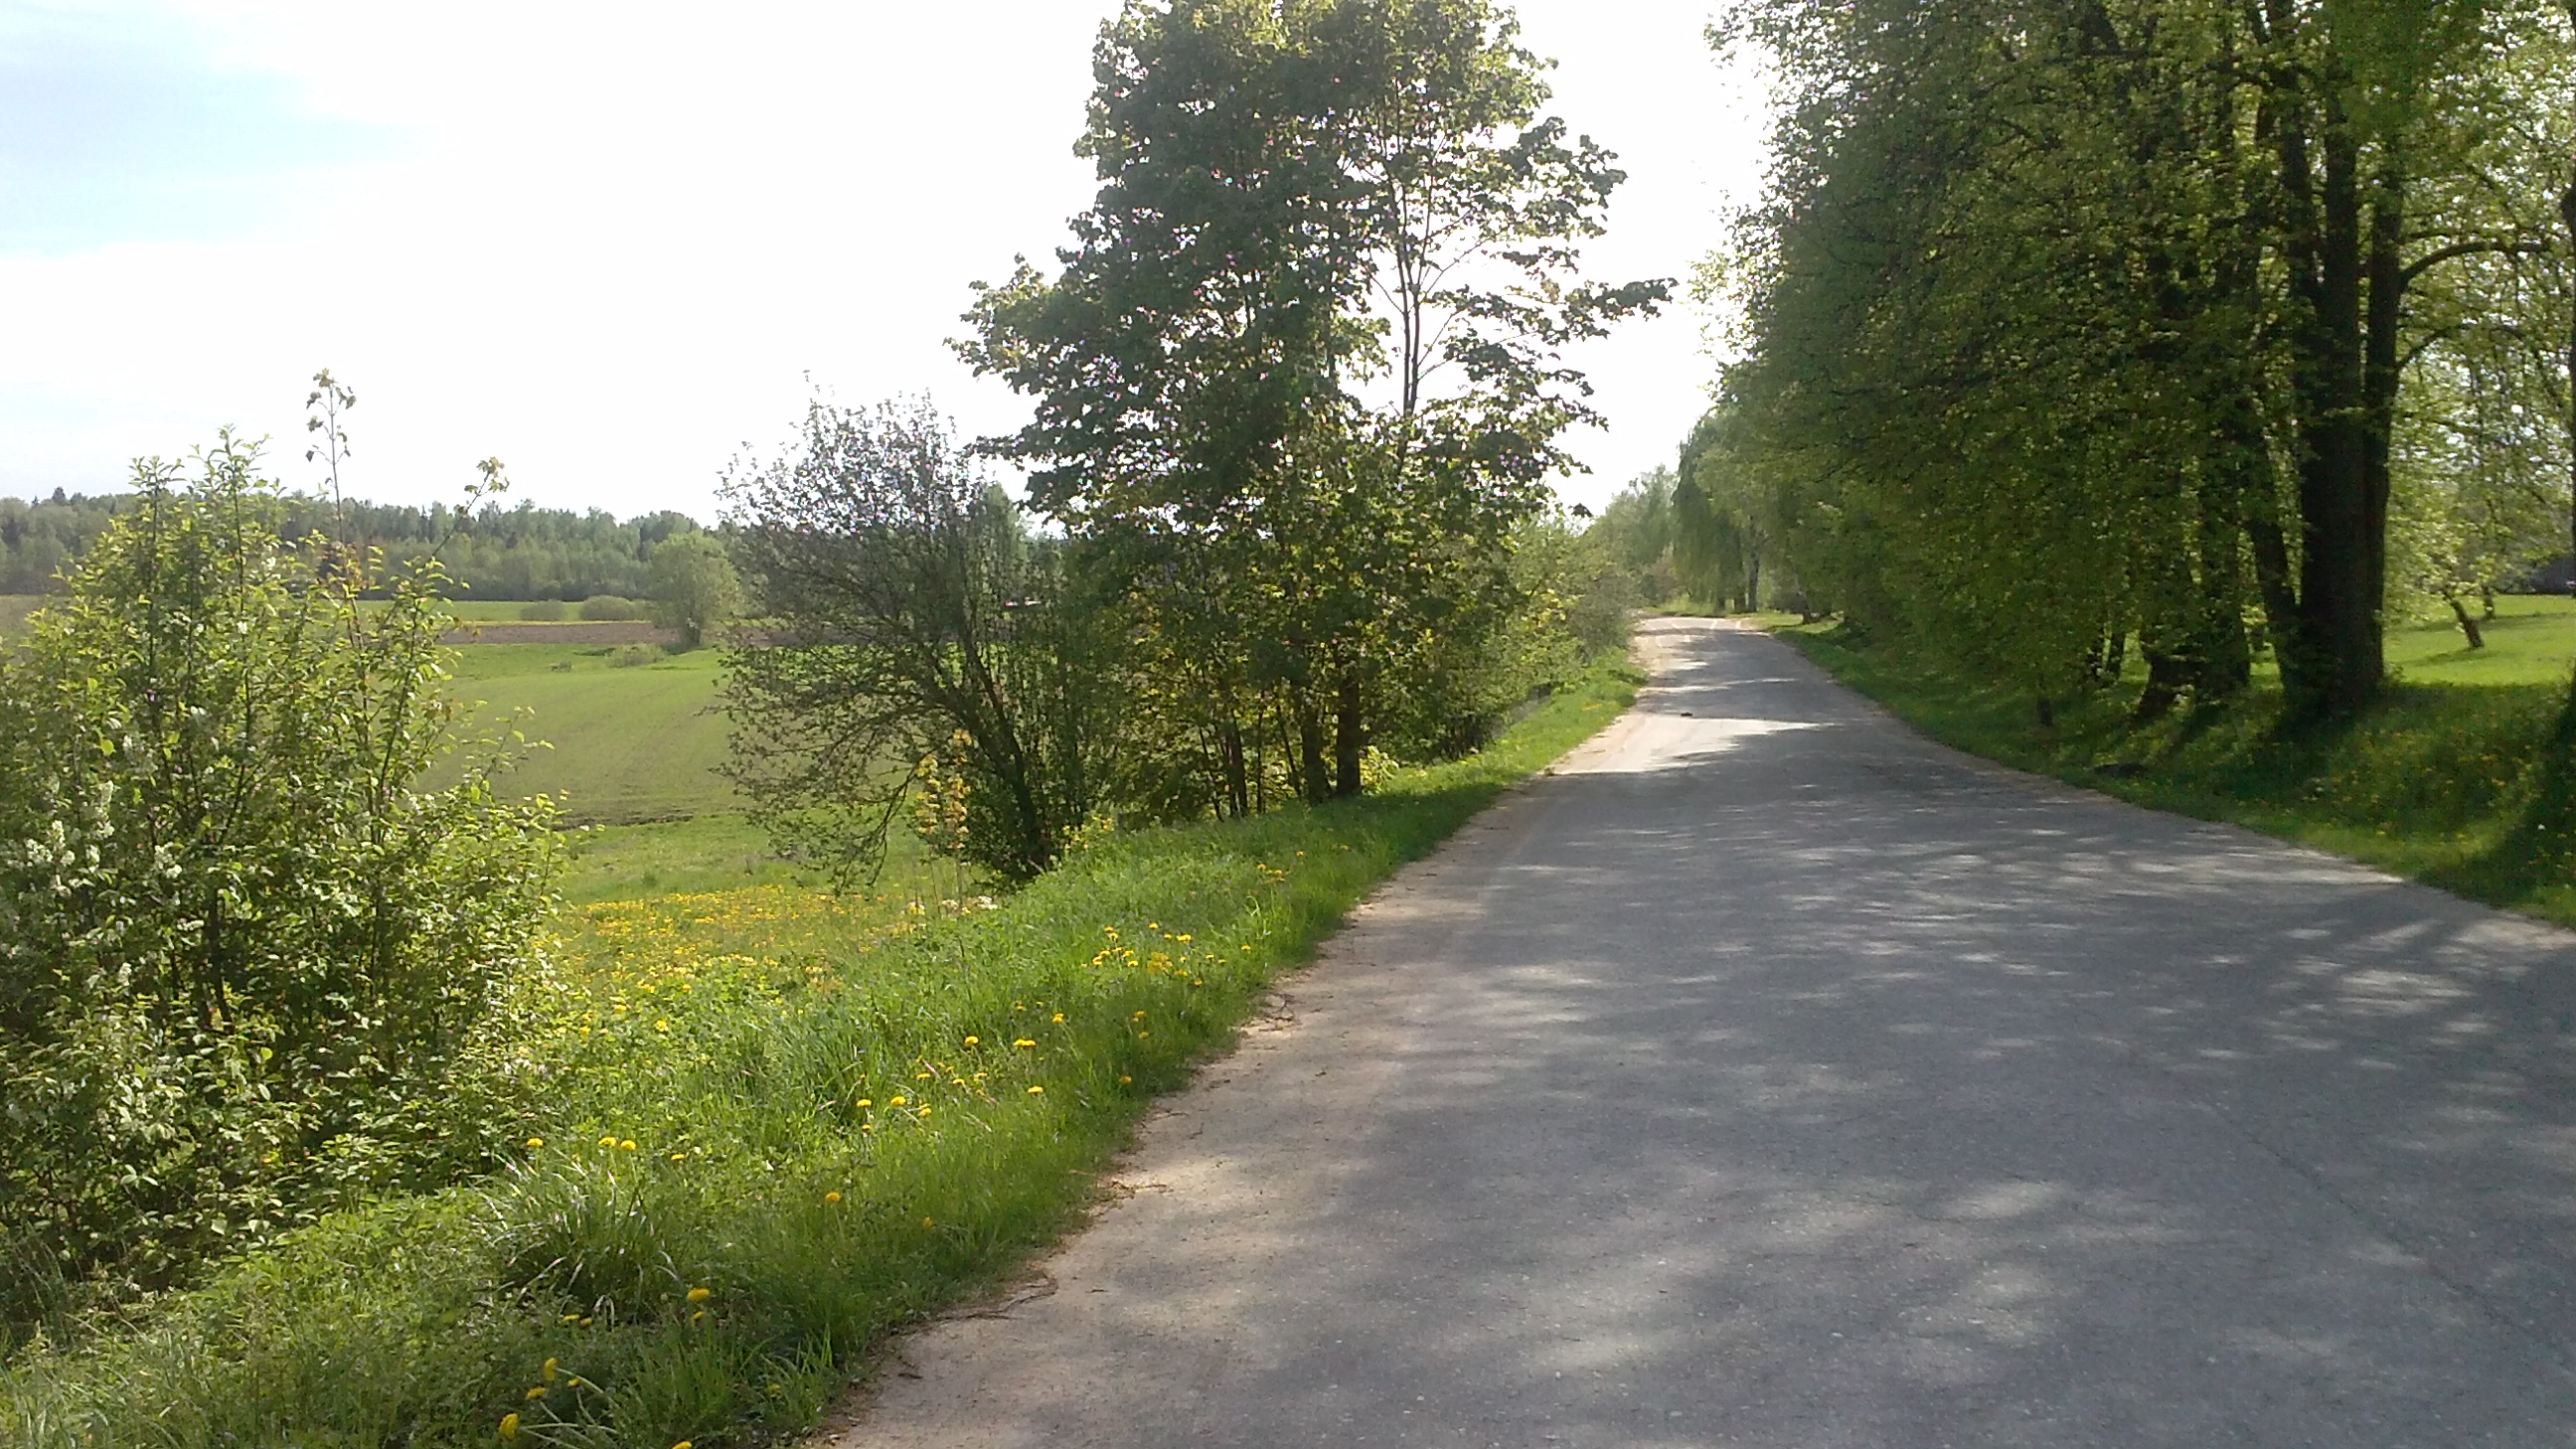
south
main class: Grassland
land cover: Grassland without tree/shrub cover
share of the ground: > 75 %
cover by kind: herbaceous plants 100 %
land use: Agriculture (excluding fallow land and kitchen gardens)
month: May
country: LV
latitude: 55.9712
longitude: 27.6020
